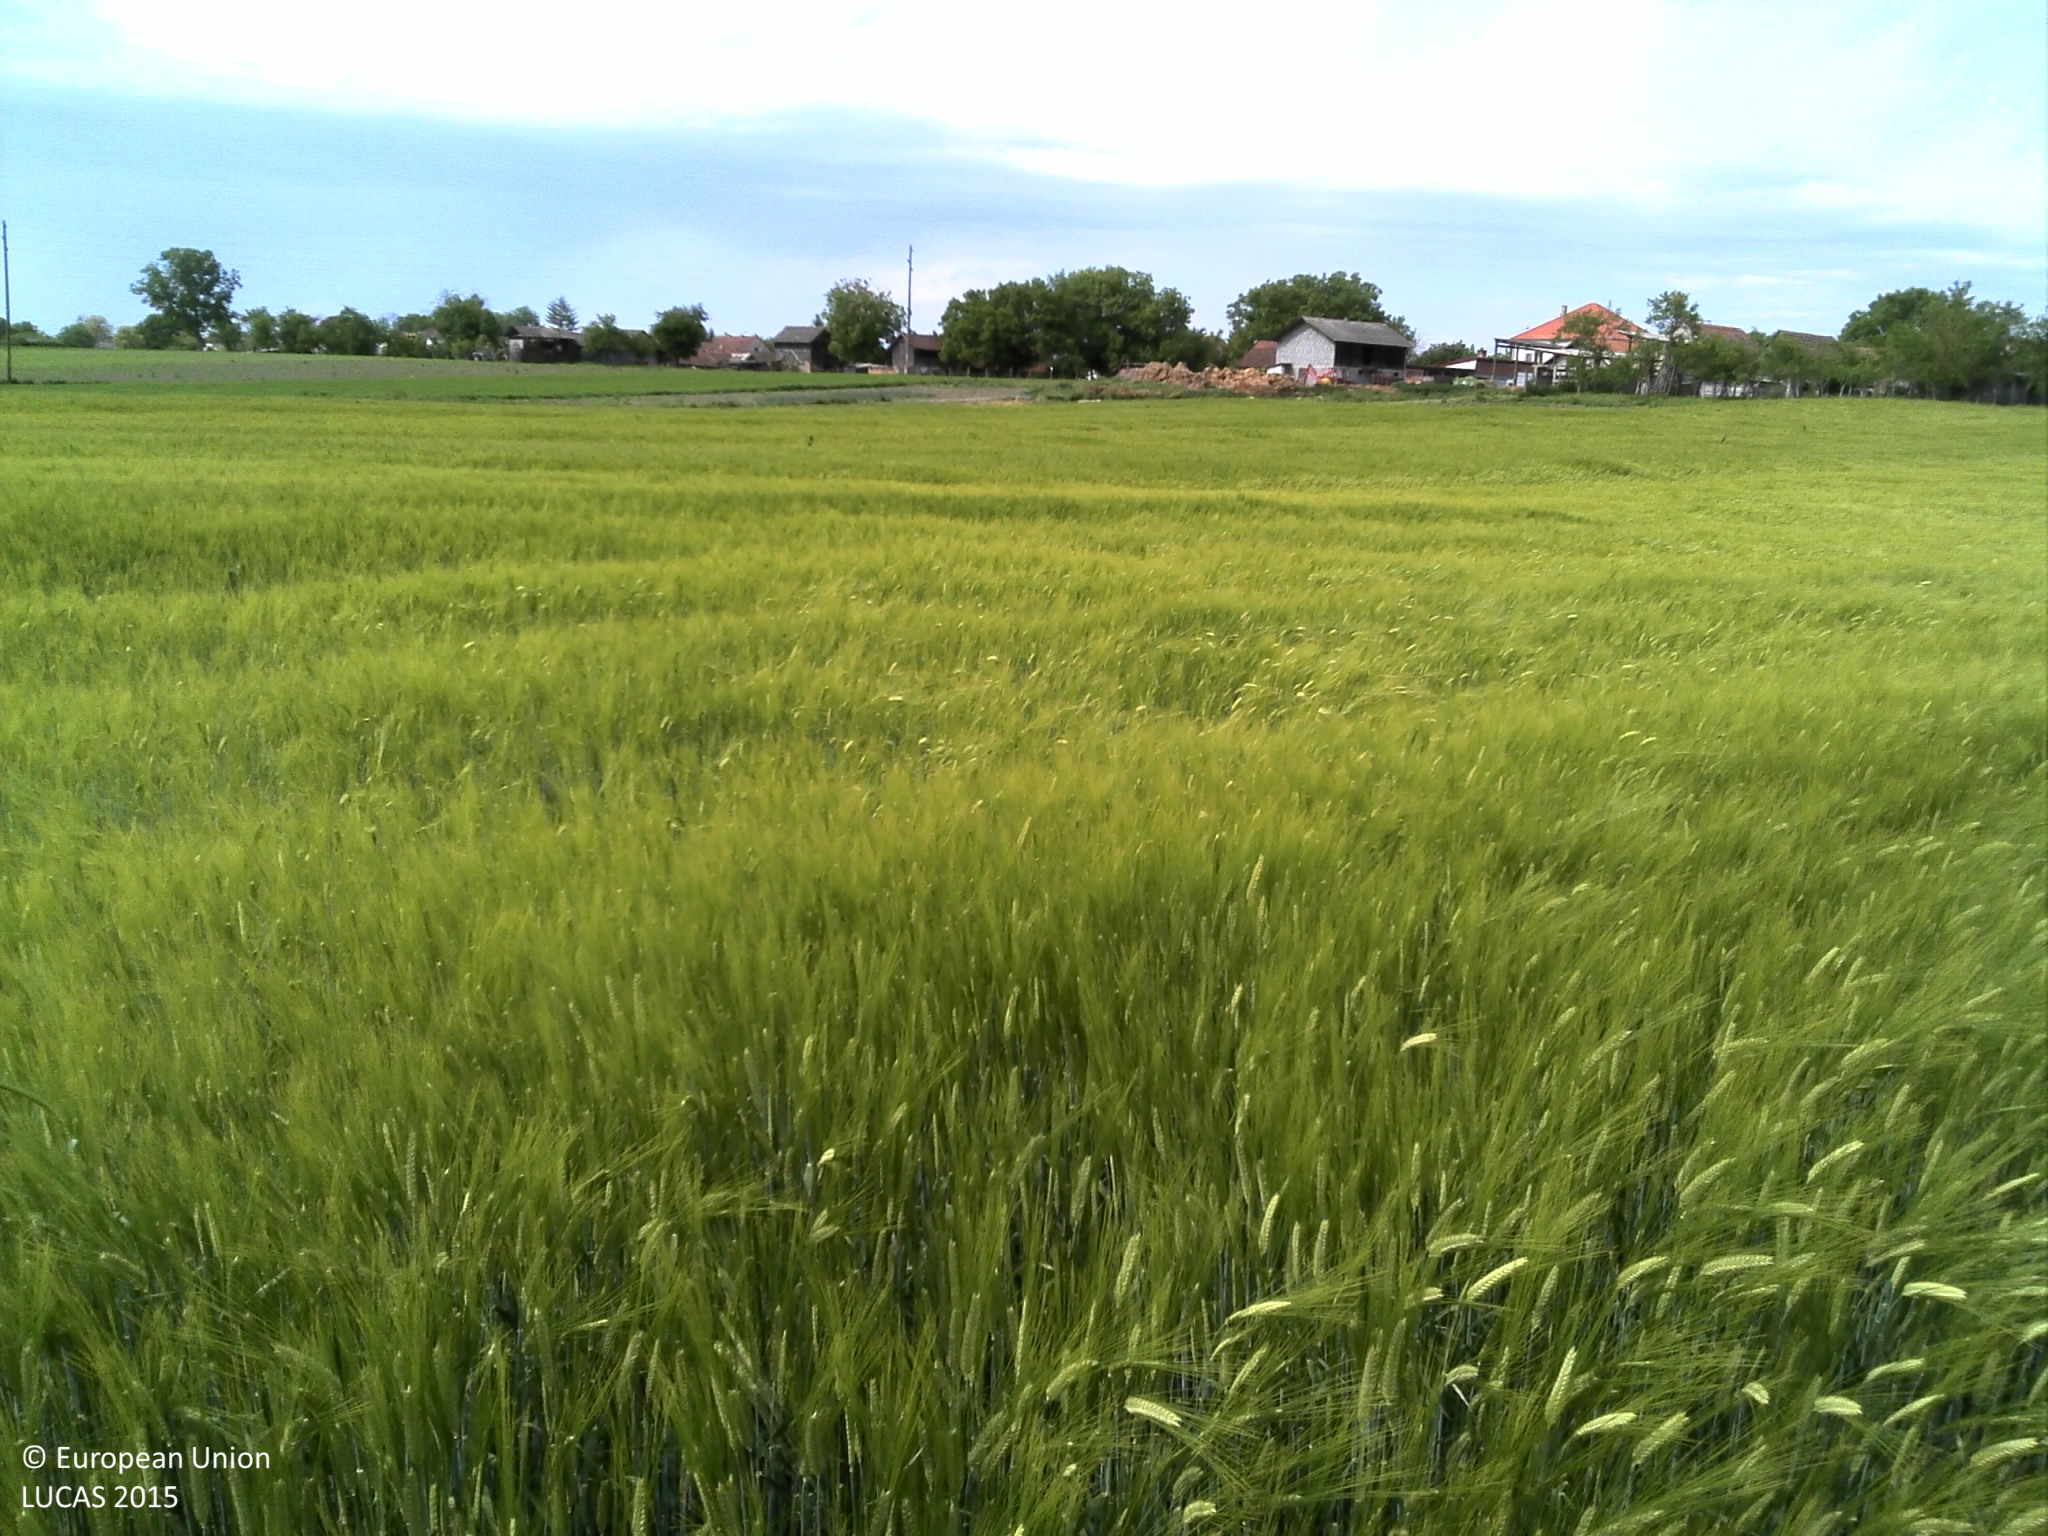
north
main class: Cropland
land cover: Barley
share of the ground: > 75 %
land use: Agriculture (excluding fallow land and kitchen gardens)
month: May
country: HR
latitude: 45.6545
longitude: 18.6702
